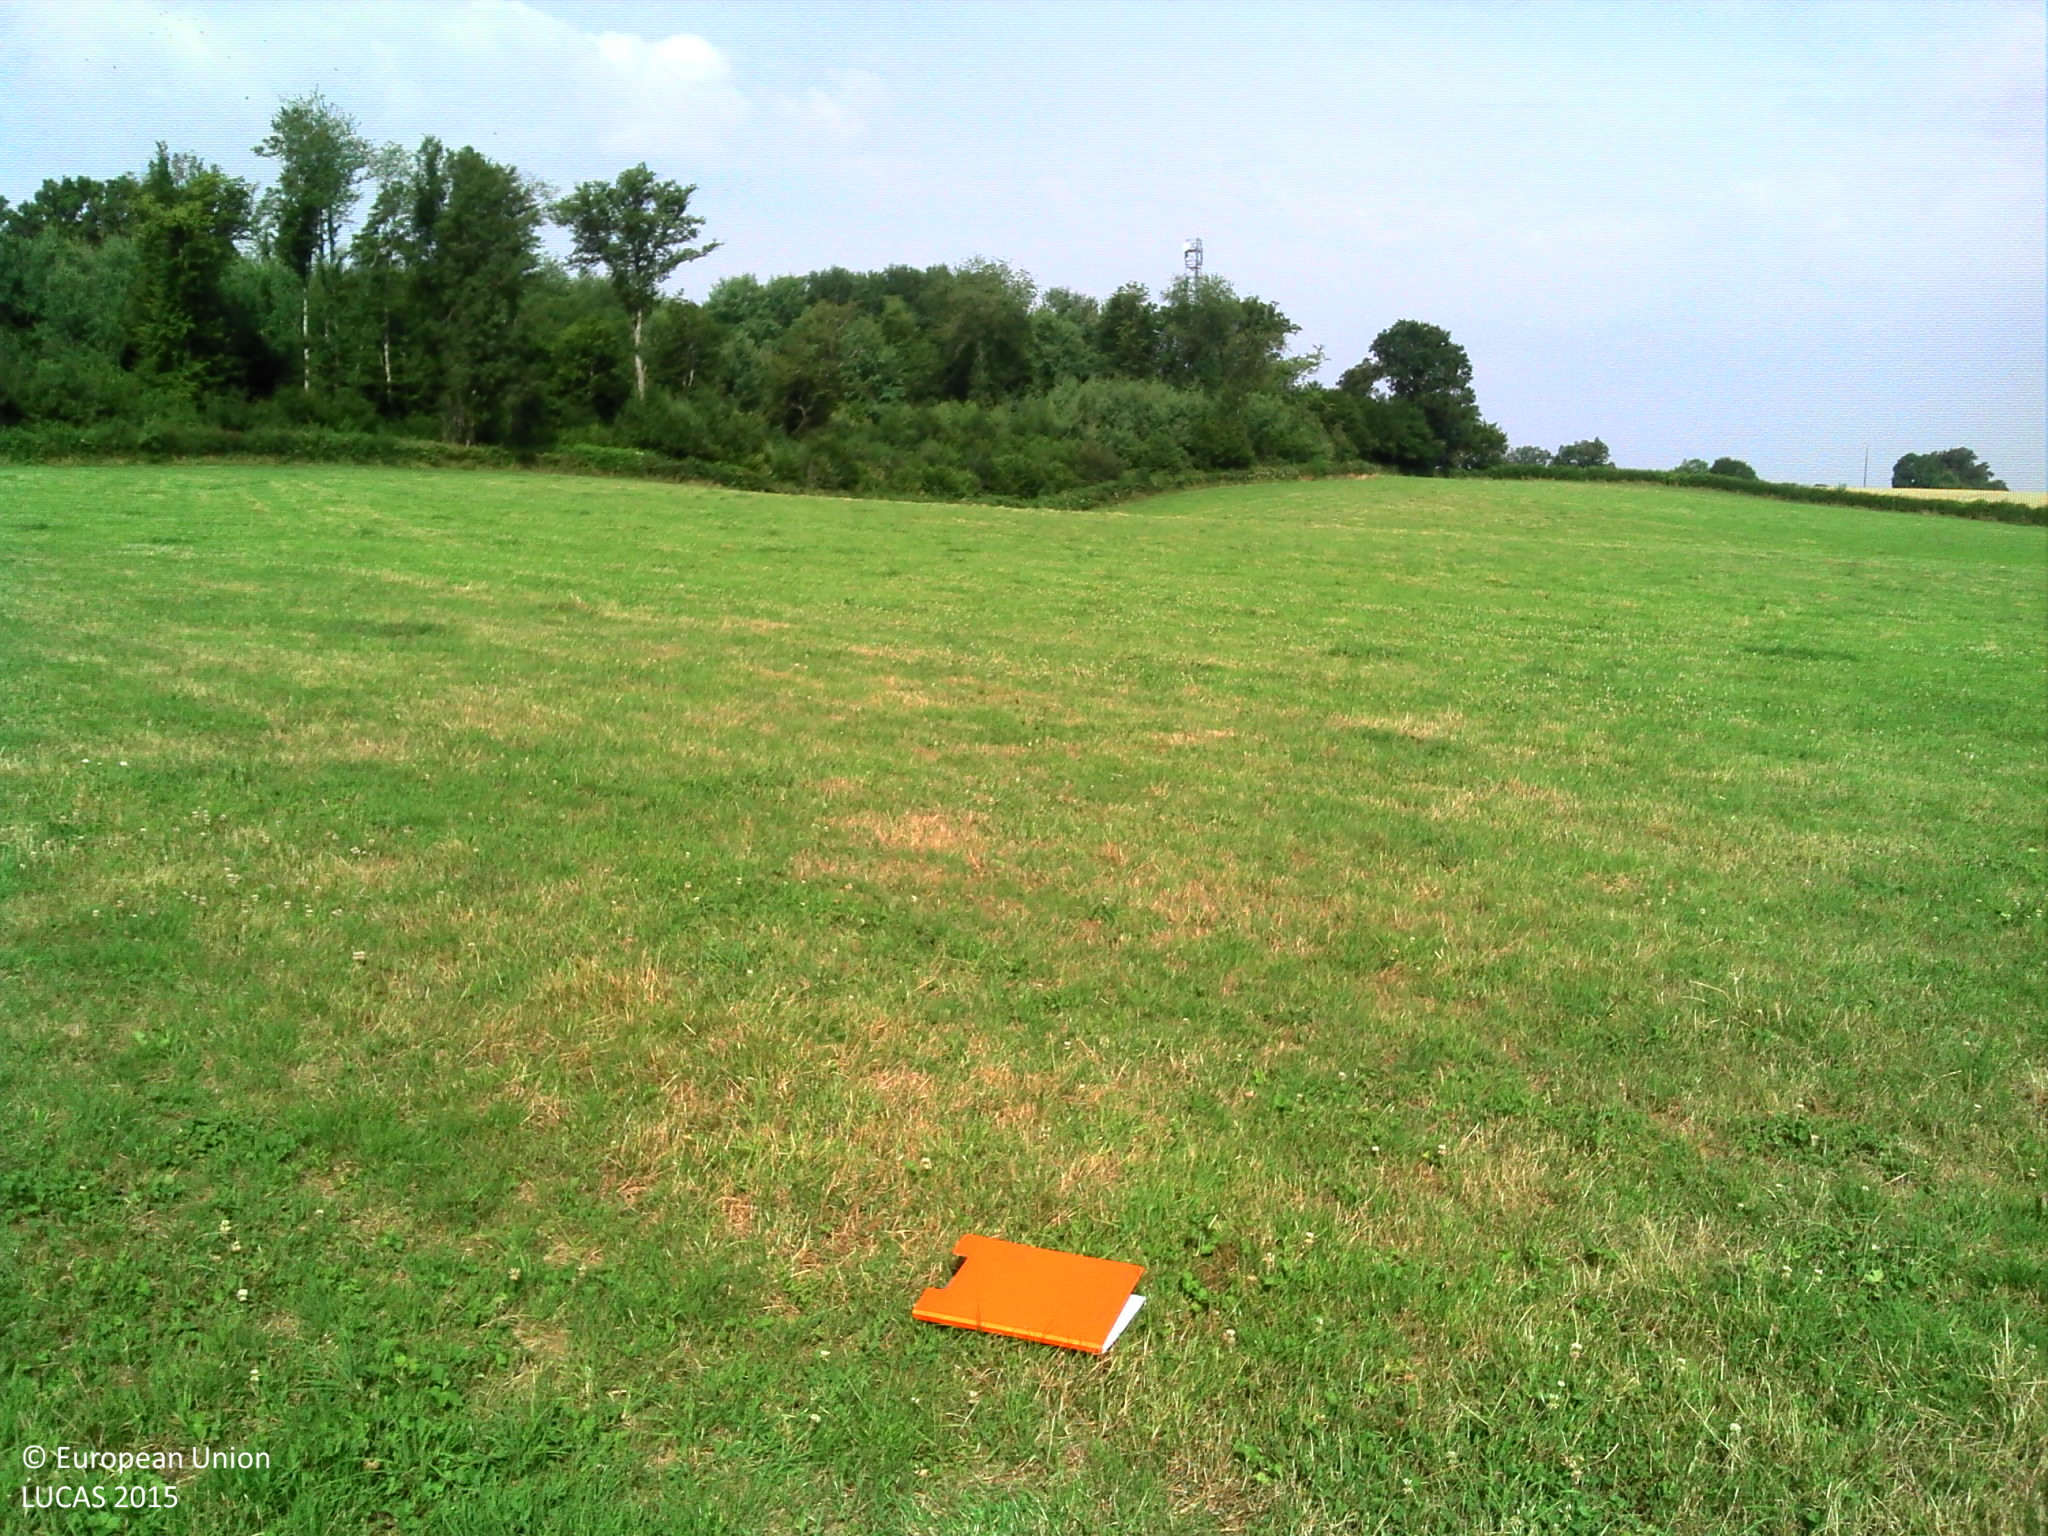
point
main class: Grassland
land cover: Grassland without tree/shrub cover
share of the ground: > 75 %
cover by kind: herbaceous plants 100 %
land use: Agriculture (excluding fallow land and kitchen gardens)
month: July
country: FR
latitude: 47.1350
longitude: 3.6031
